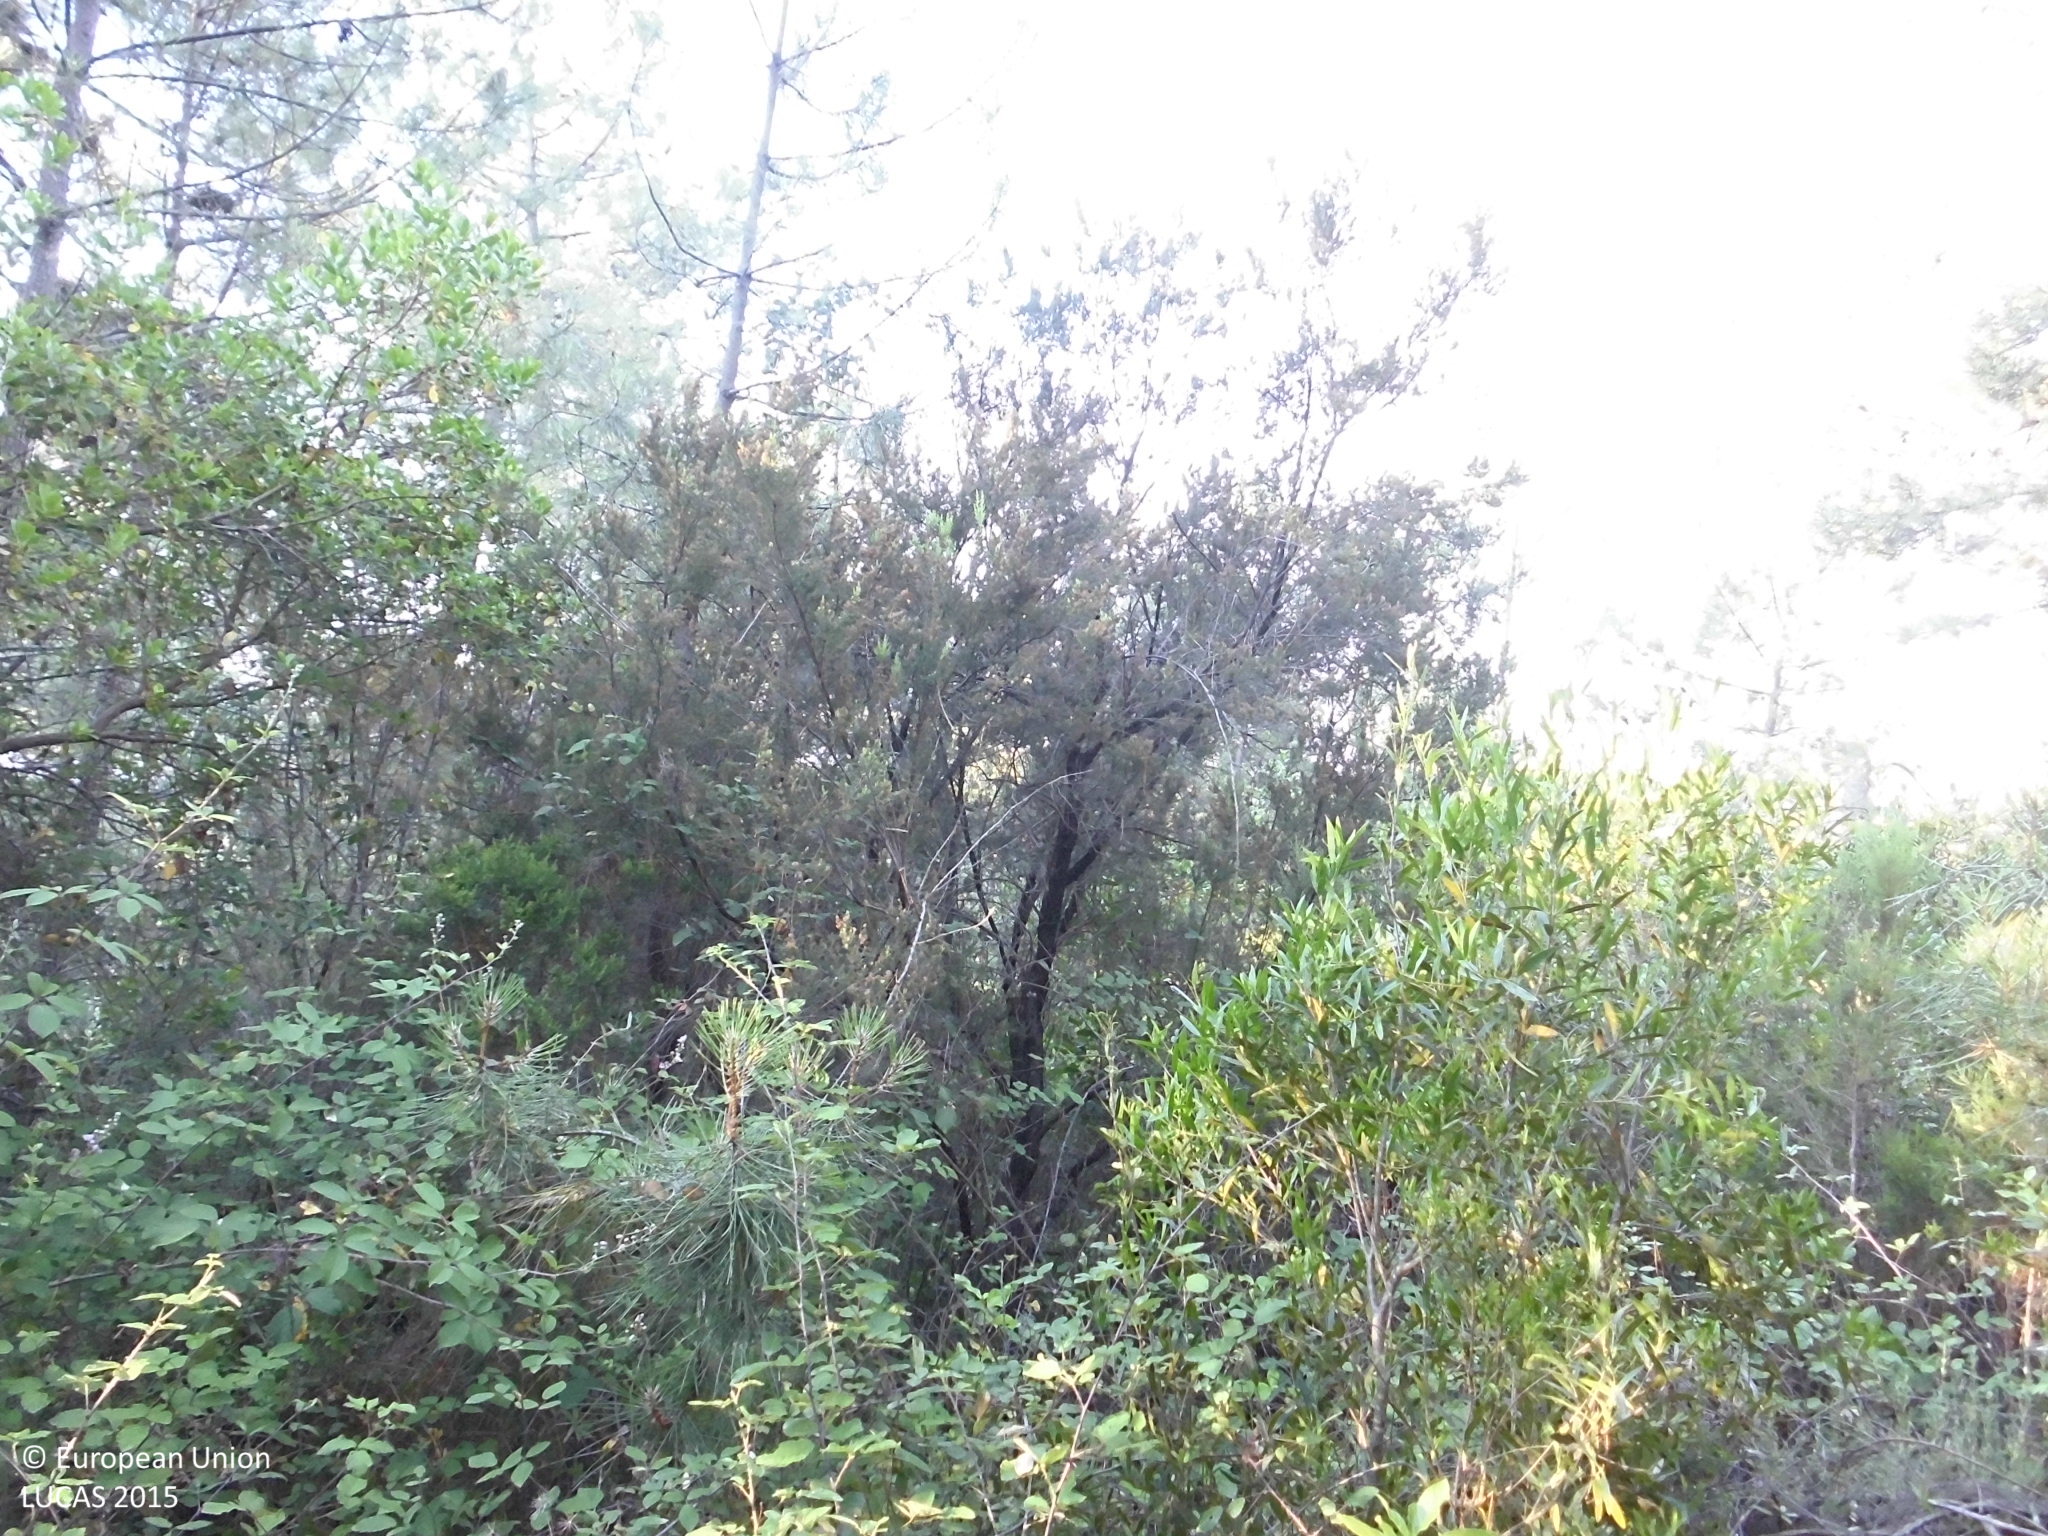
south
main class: Woodland
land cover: Pine dominated mixed woodland
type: thermophilous deciduous forest
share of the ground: > 75 %
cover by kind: coniferous forest trees 50 %, broadleaved forest trees 25 %, shrubs 20 %, herbaceous plants 5 %
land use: Forestry
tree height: > 5 m
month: June
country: ES
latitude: 40.1169
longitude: -5.4668
